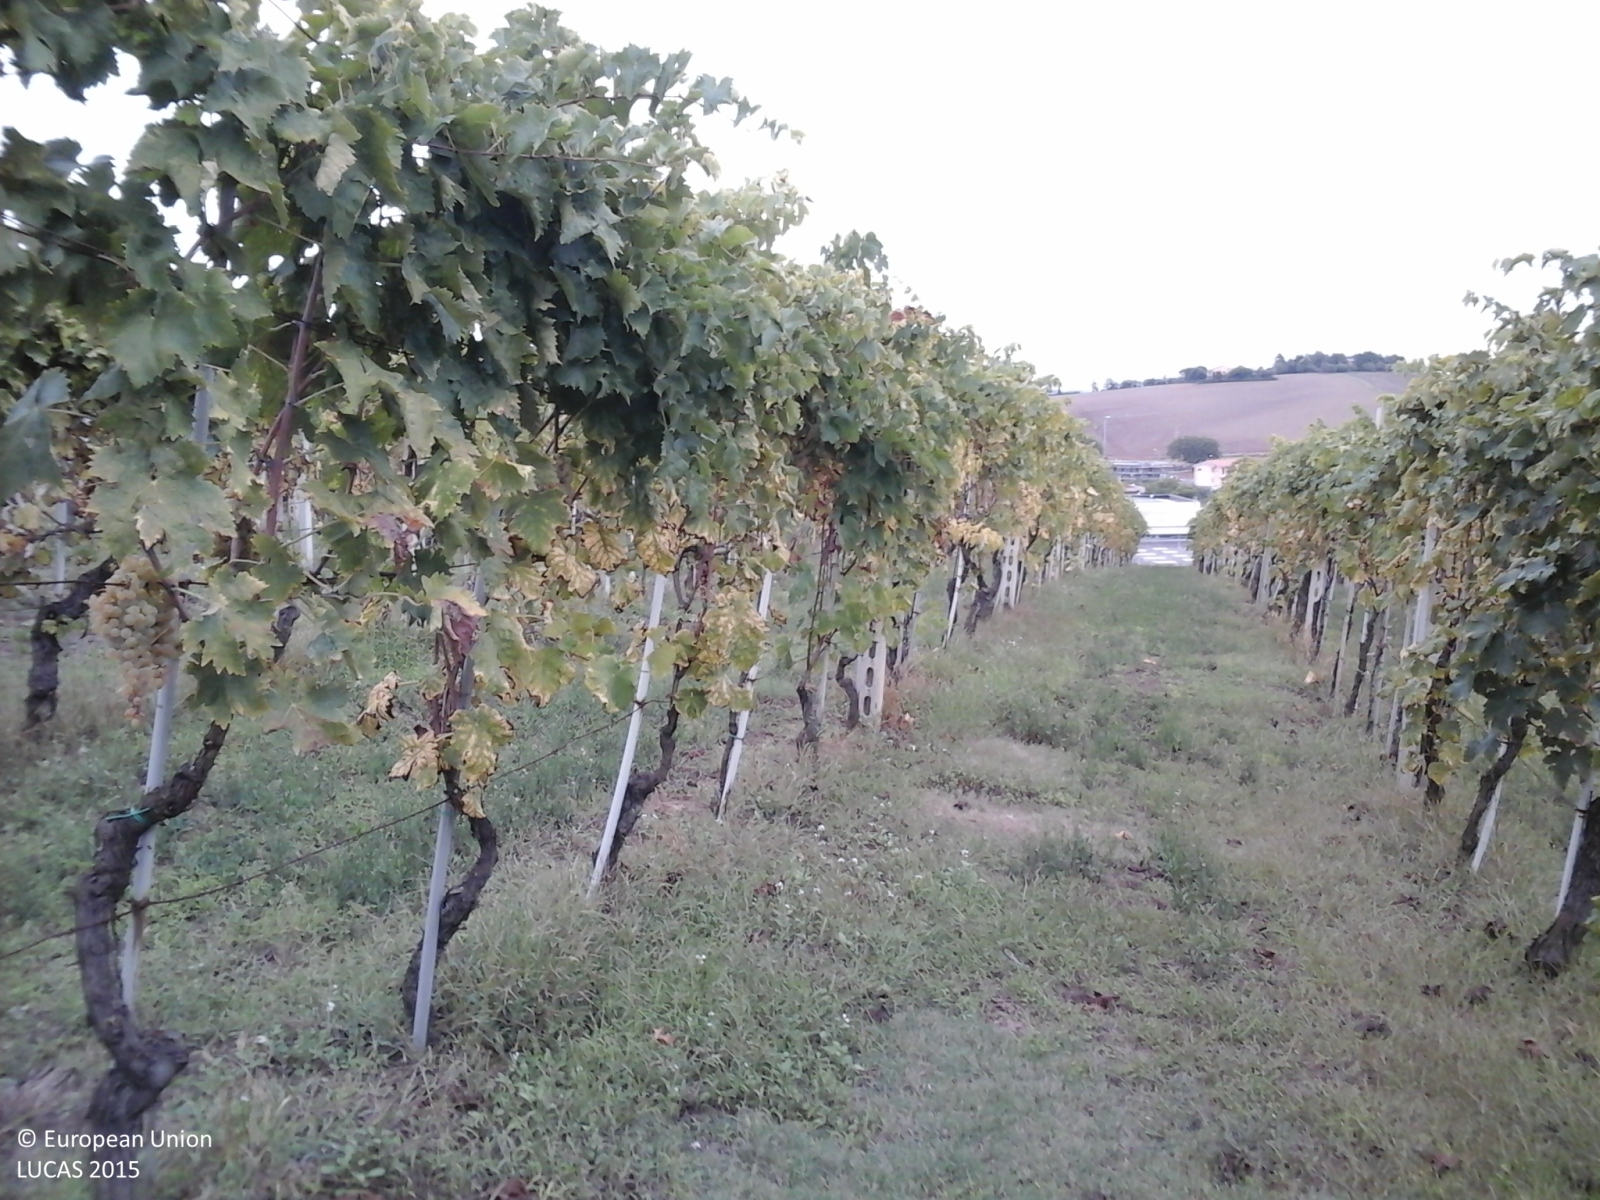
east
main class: Cropland
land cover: Vineyards
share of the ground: 50 - 75 %
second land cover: Grassland without tree/shrub cover
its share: > 75 %
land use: Agriculture (excluding fallow land and kitchen gardens)
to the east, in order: Vineyards; Grassland without tree/shrub cover; Electric lines; Abandoned hedges; Spontaneously vegetated surfaces; Artificial constructions in urban areas
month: October
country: IT
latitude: 43.5153
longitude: 13.4924
